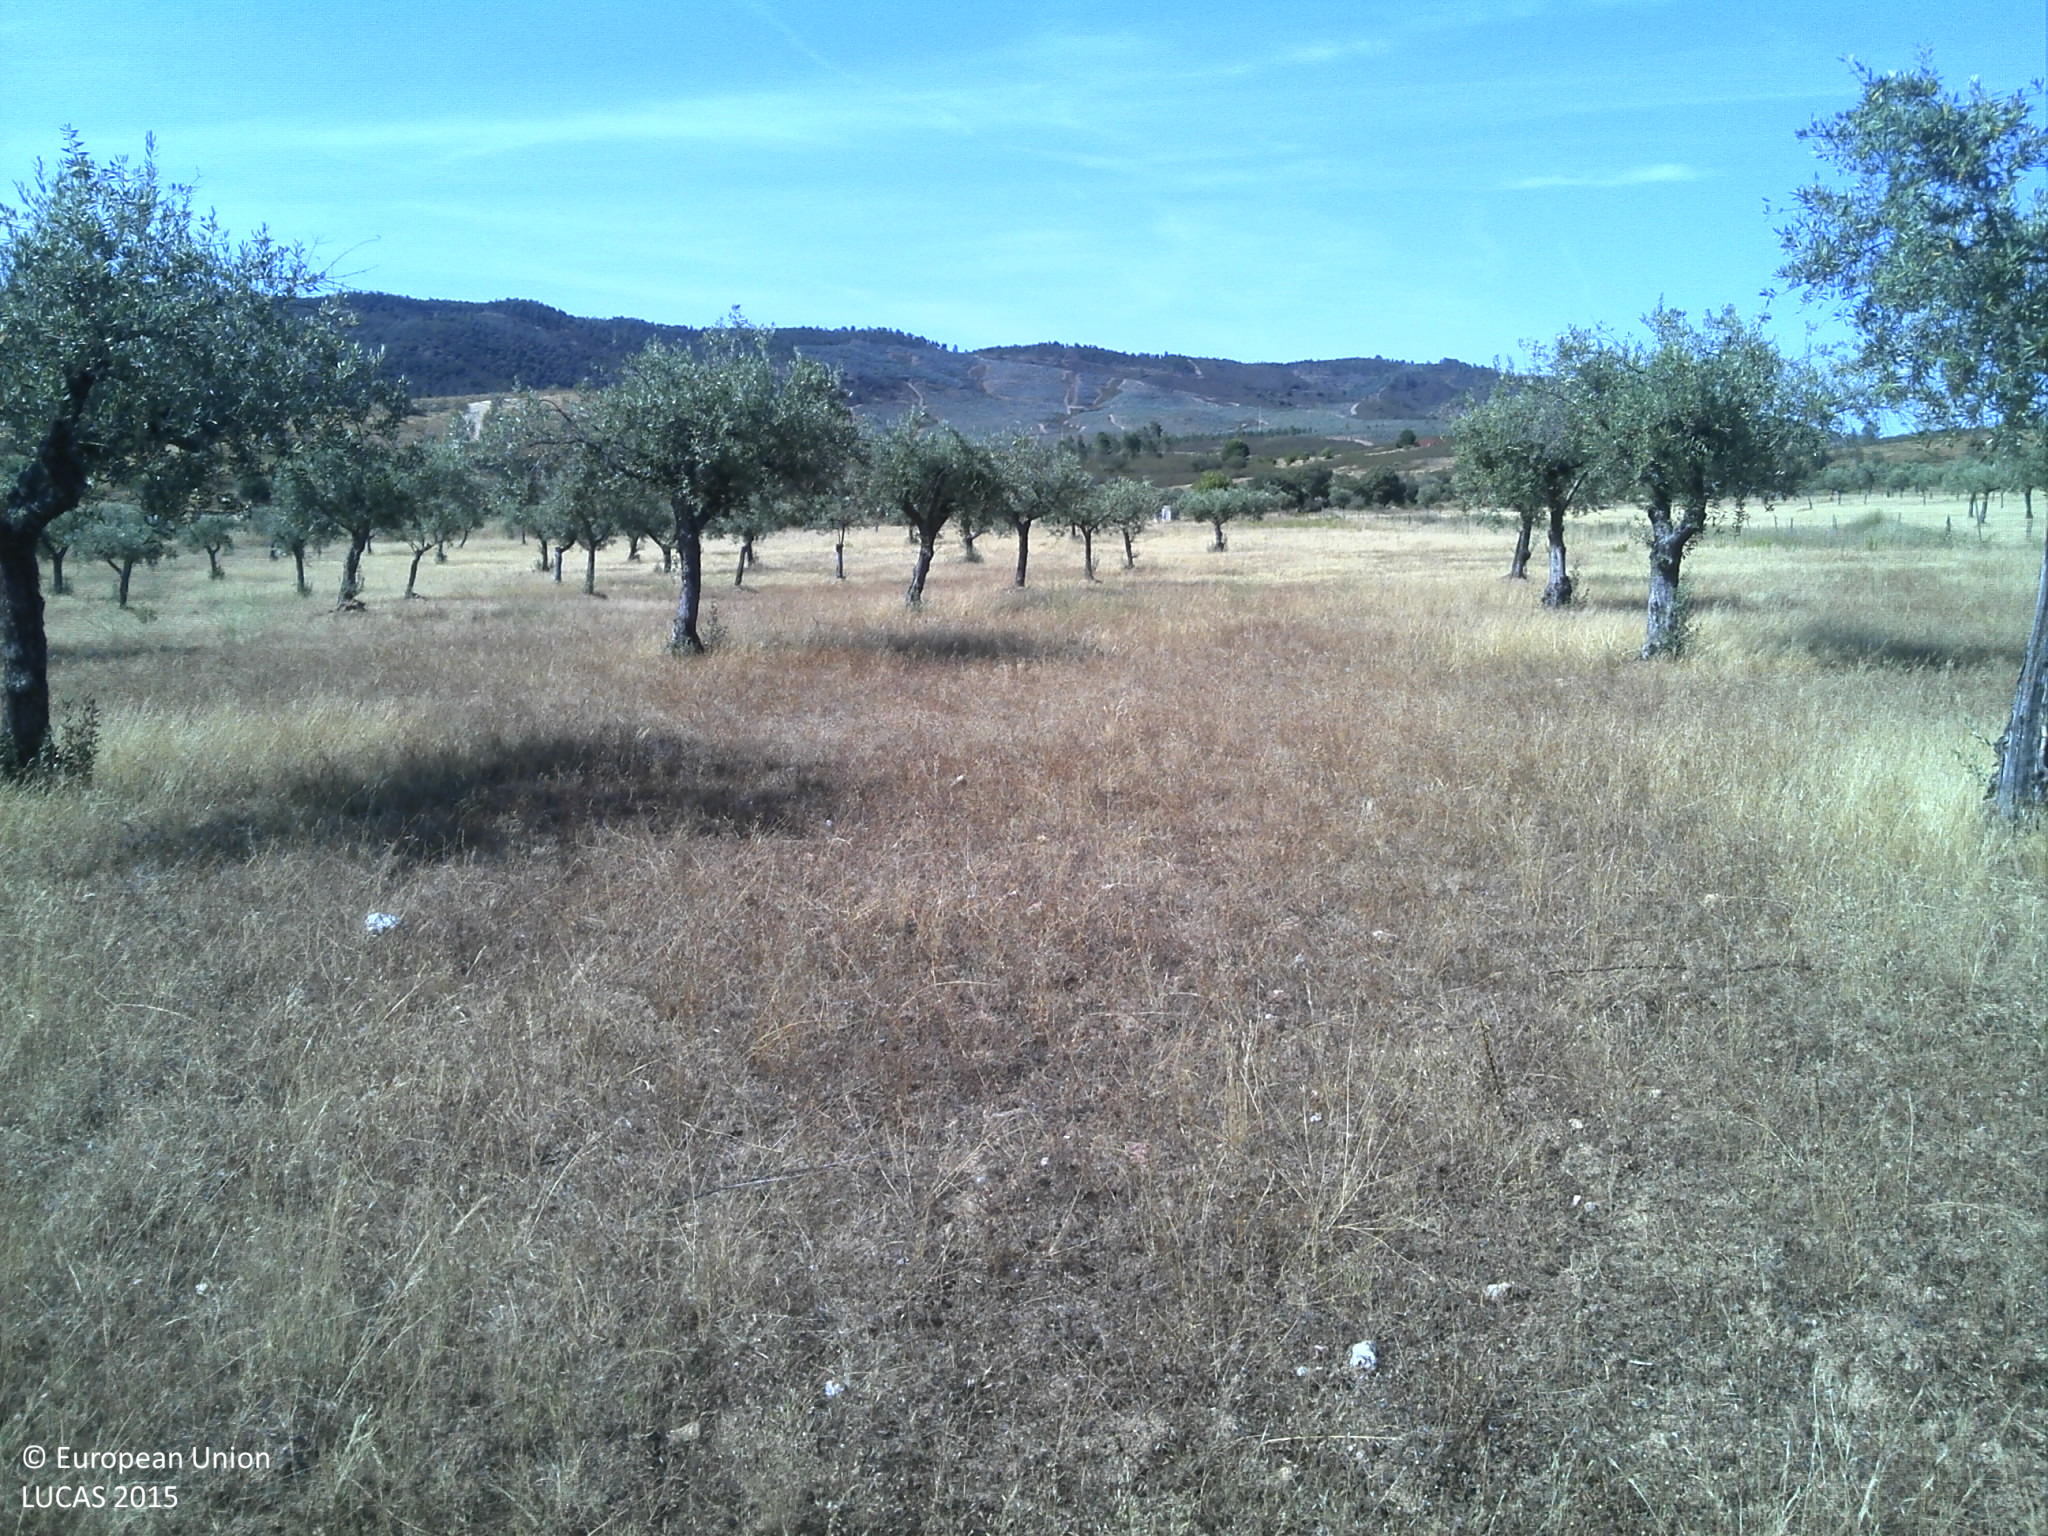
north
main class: Cropland
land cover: Olive groves
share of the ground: 25 - 50 %
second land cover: Grassland without tree/shrub cover
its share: 25 - 50 %
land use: Agriculture (excluding fallow land and kitchen gardens)
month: July
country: PT
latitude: 39.6996
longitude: -7.5808
